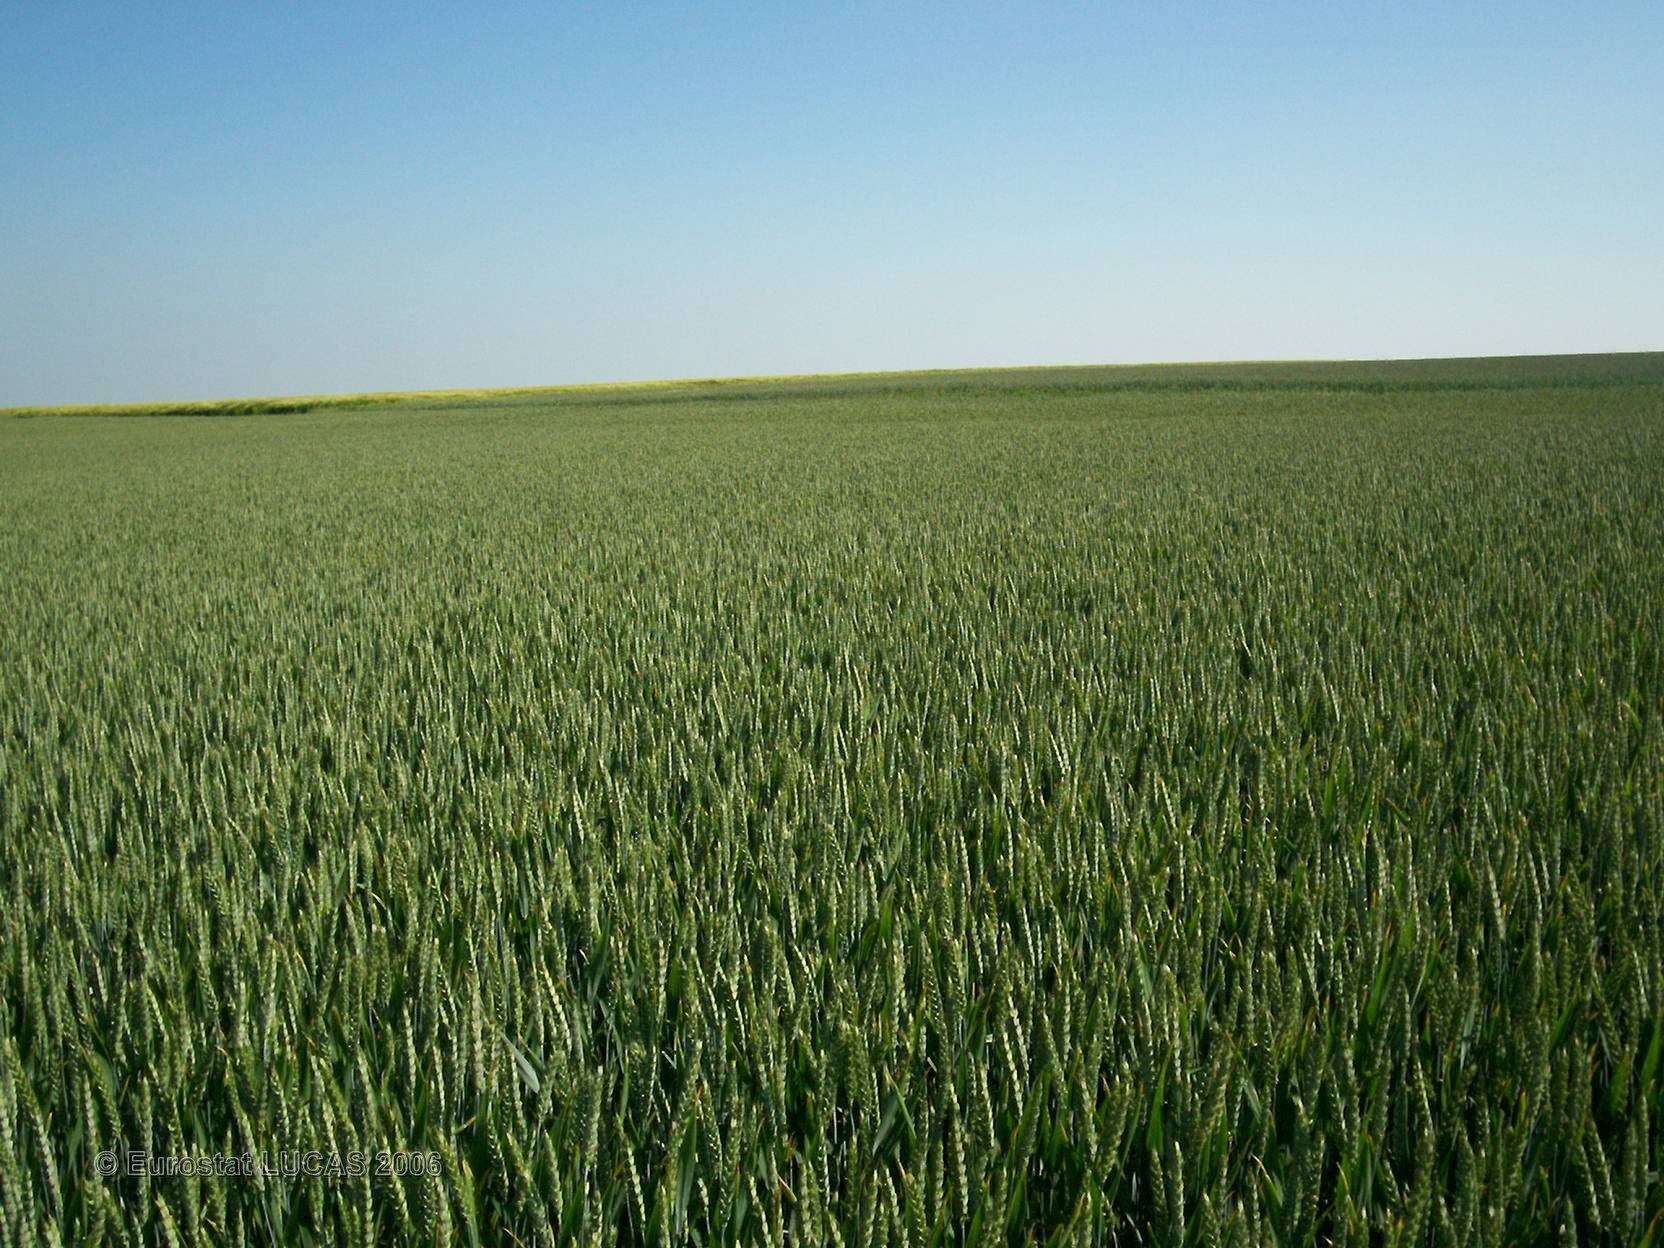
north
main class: Cropland
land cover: Common wheat
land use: Agriculture (excluding fallow land and kitchen gardens)
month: June
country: FR
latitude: 48.8233
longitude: 4.4531
